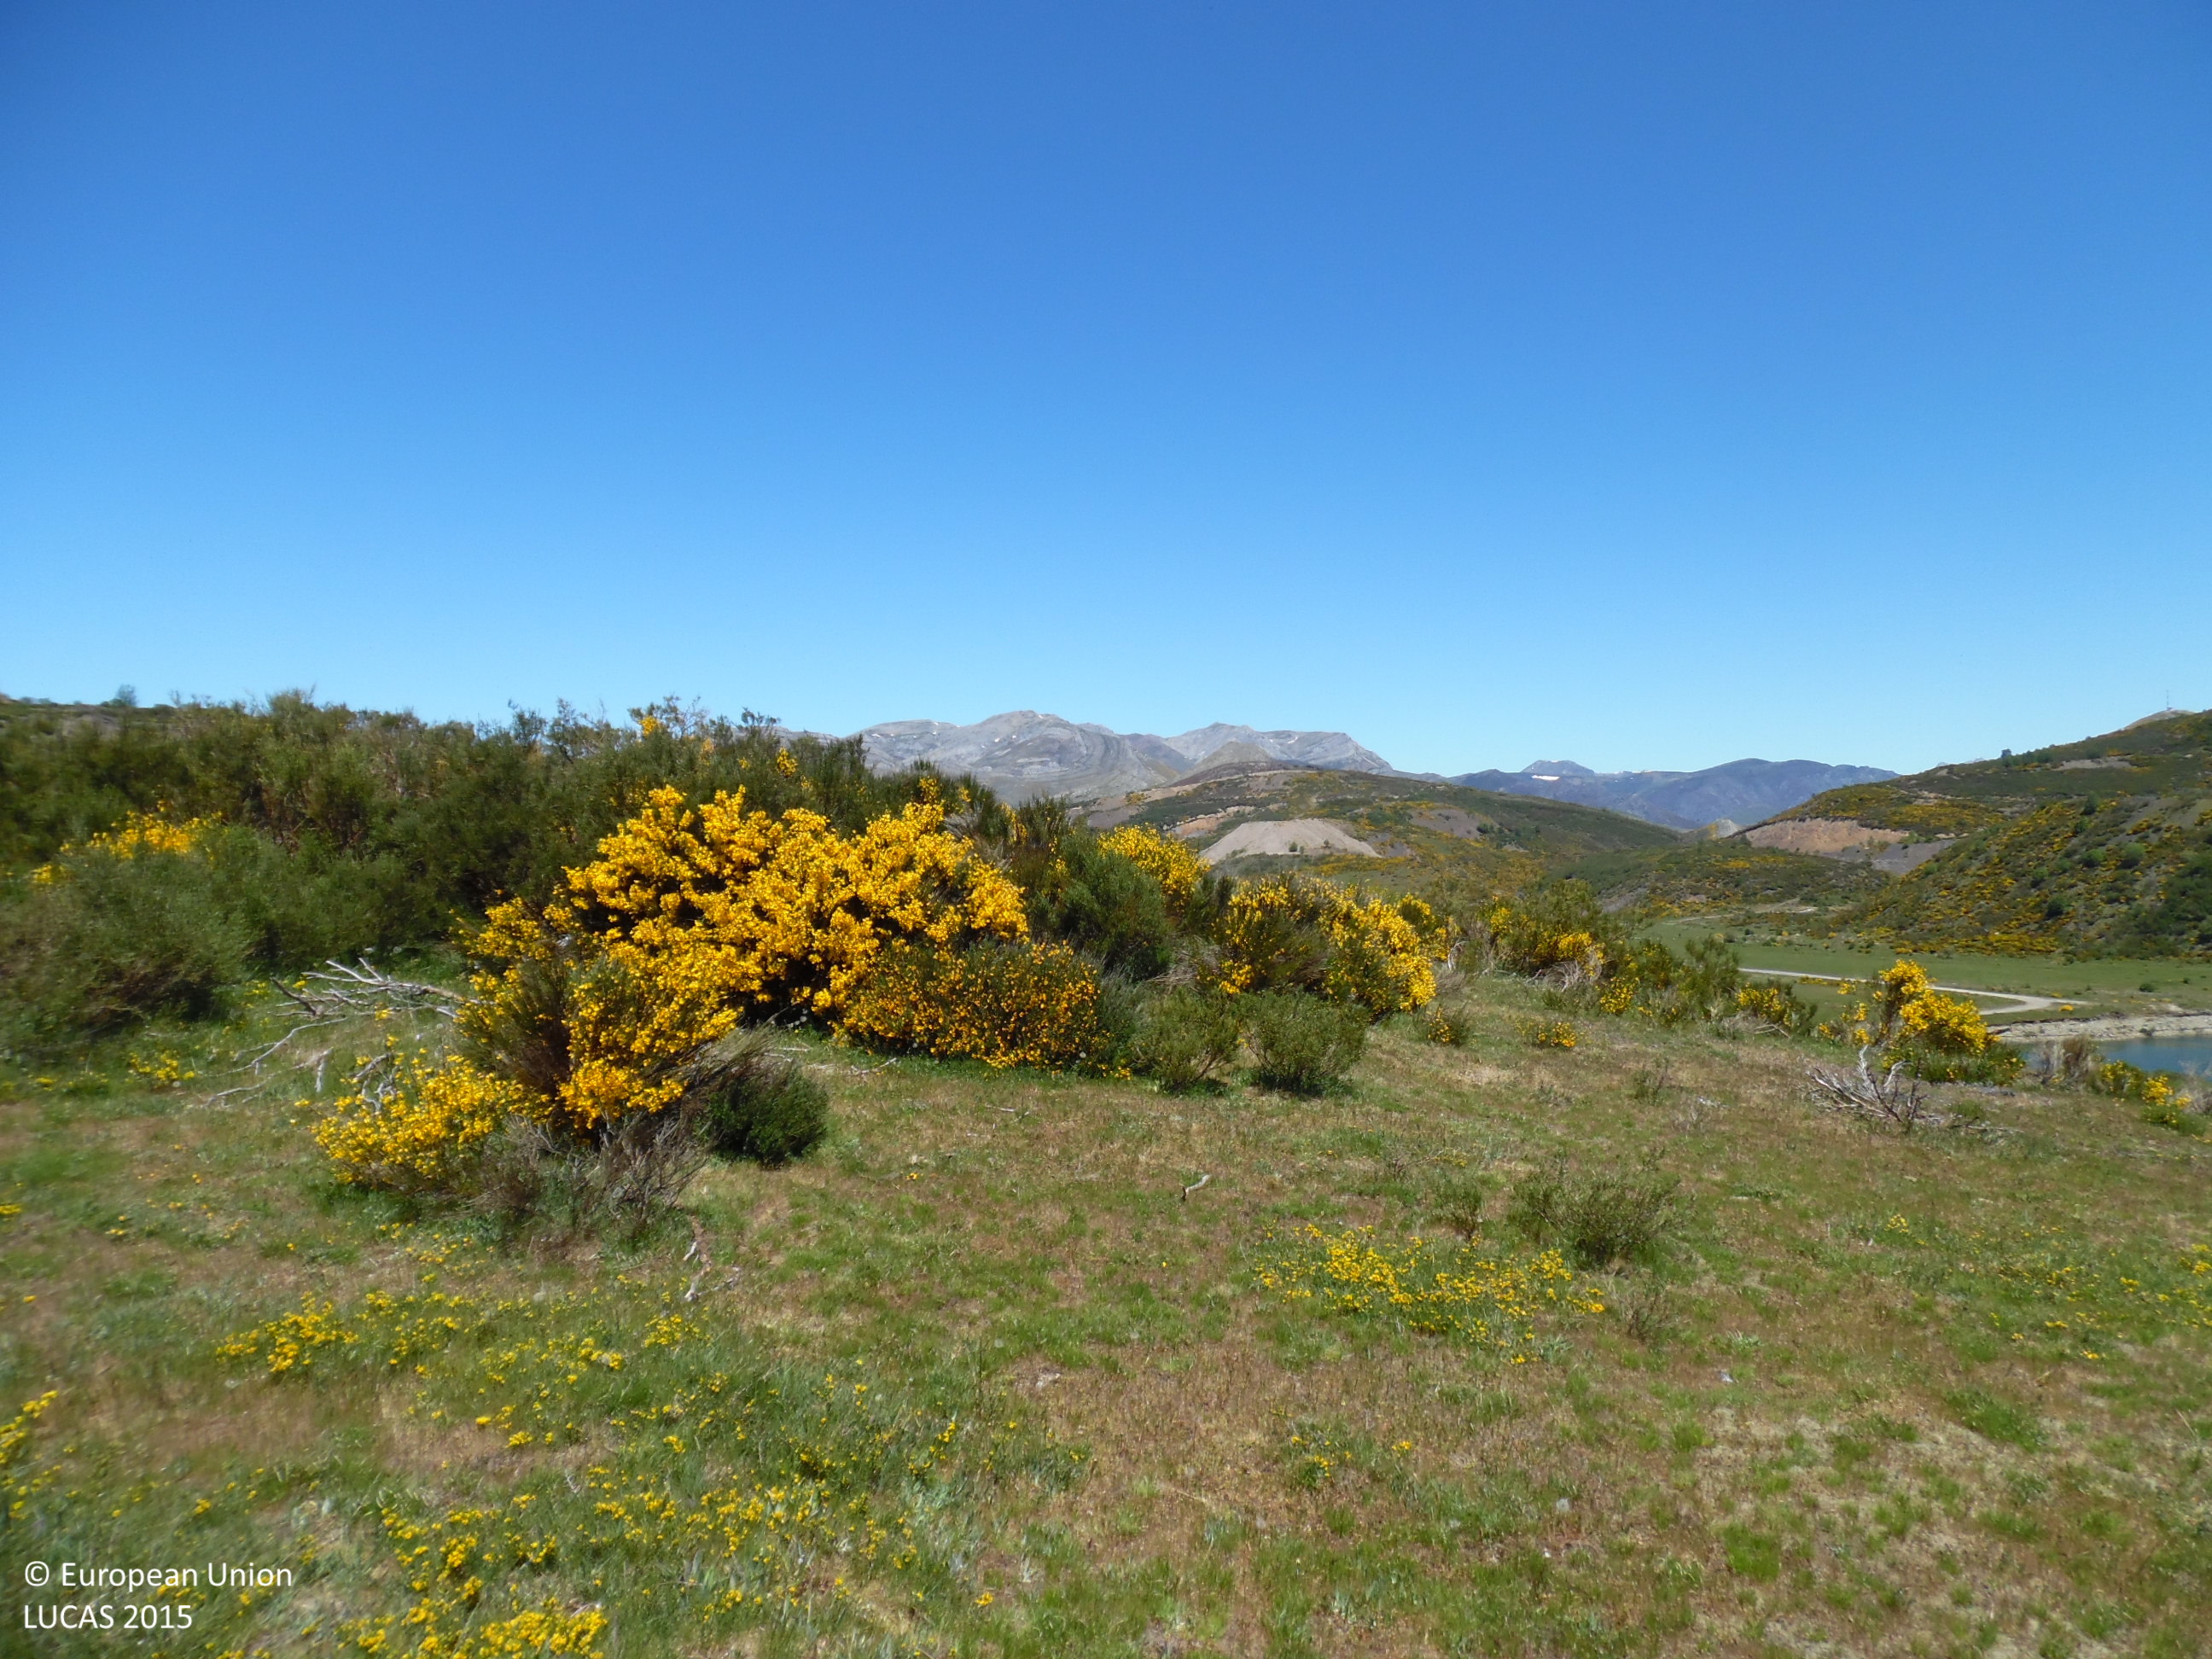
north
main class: Shrubland
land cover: Shrubland with sparse tree cover
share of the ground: 50 - 75 %
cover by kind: shrubs 95 %, broadleaved forest trees 5 %
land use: Other primary production
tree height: < 5 m
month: May
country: ES
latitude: 42.9203
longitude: -6.2005
